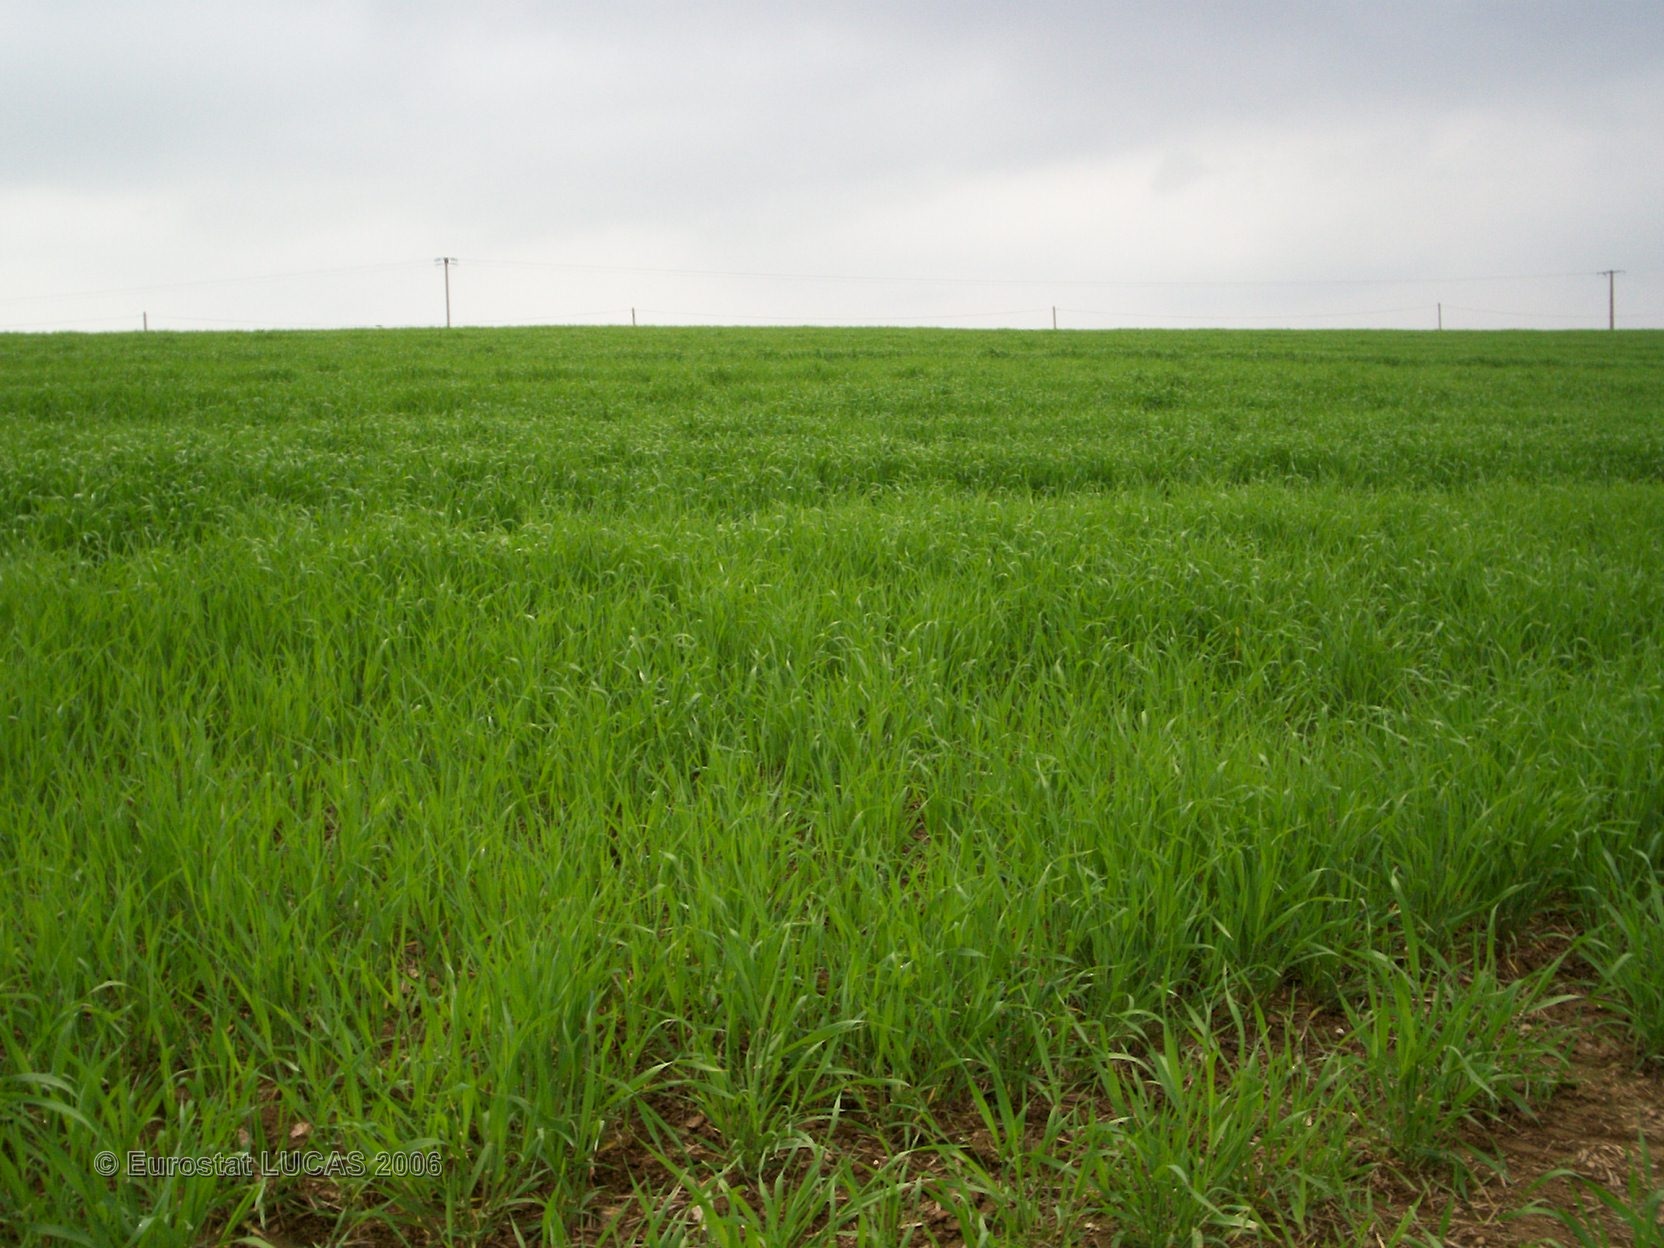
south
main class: Cropland
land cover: Barley
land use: Agriculture (excluding fallow land and kitchen gardens)
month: May
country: FR
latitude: 48.1661
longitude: -2.7982
